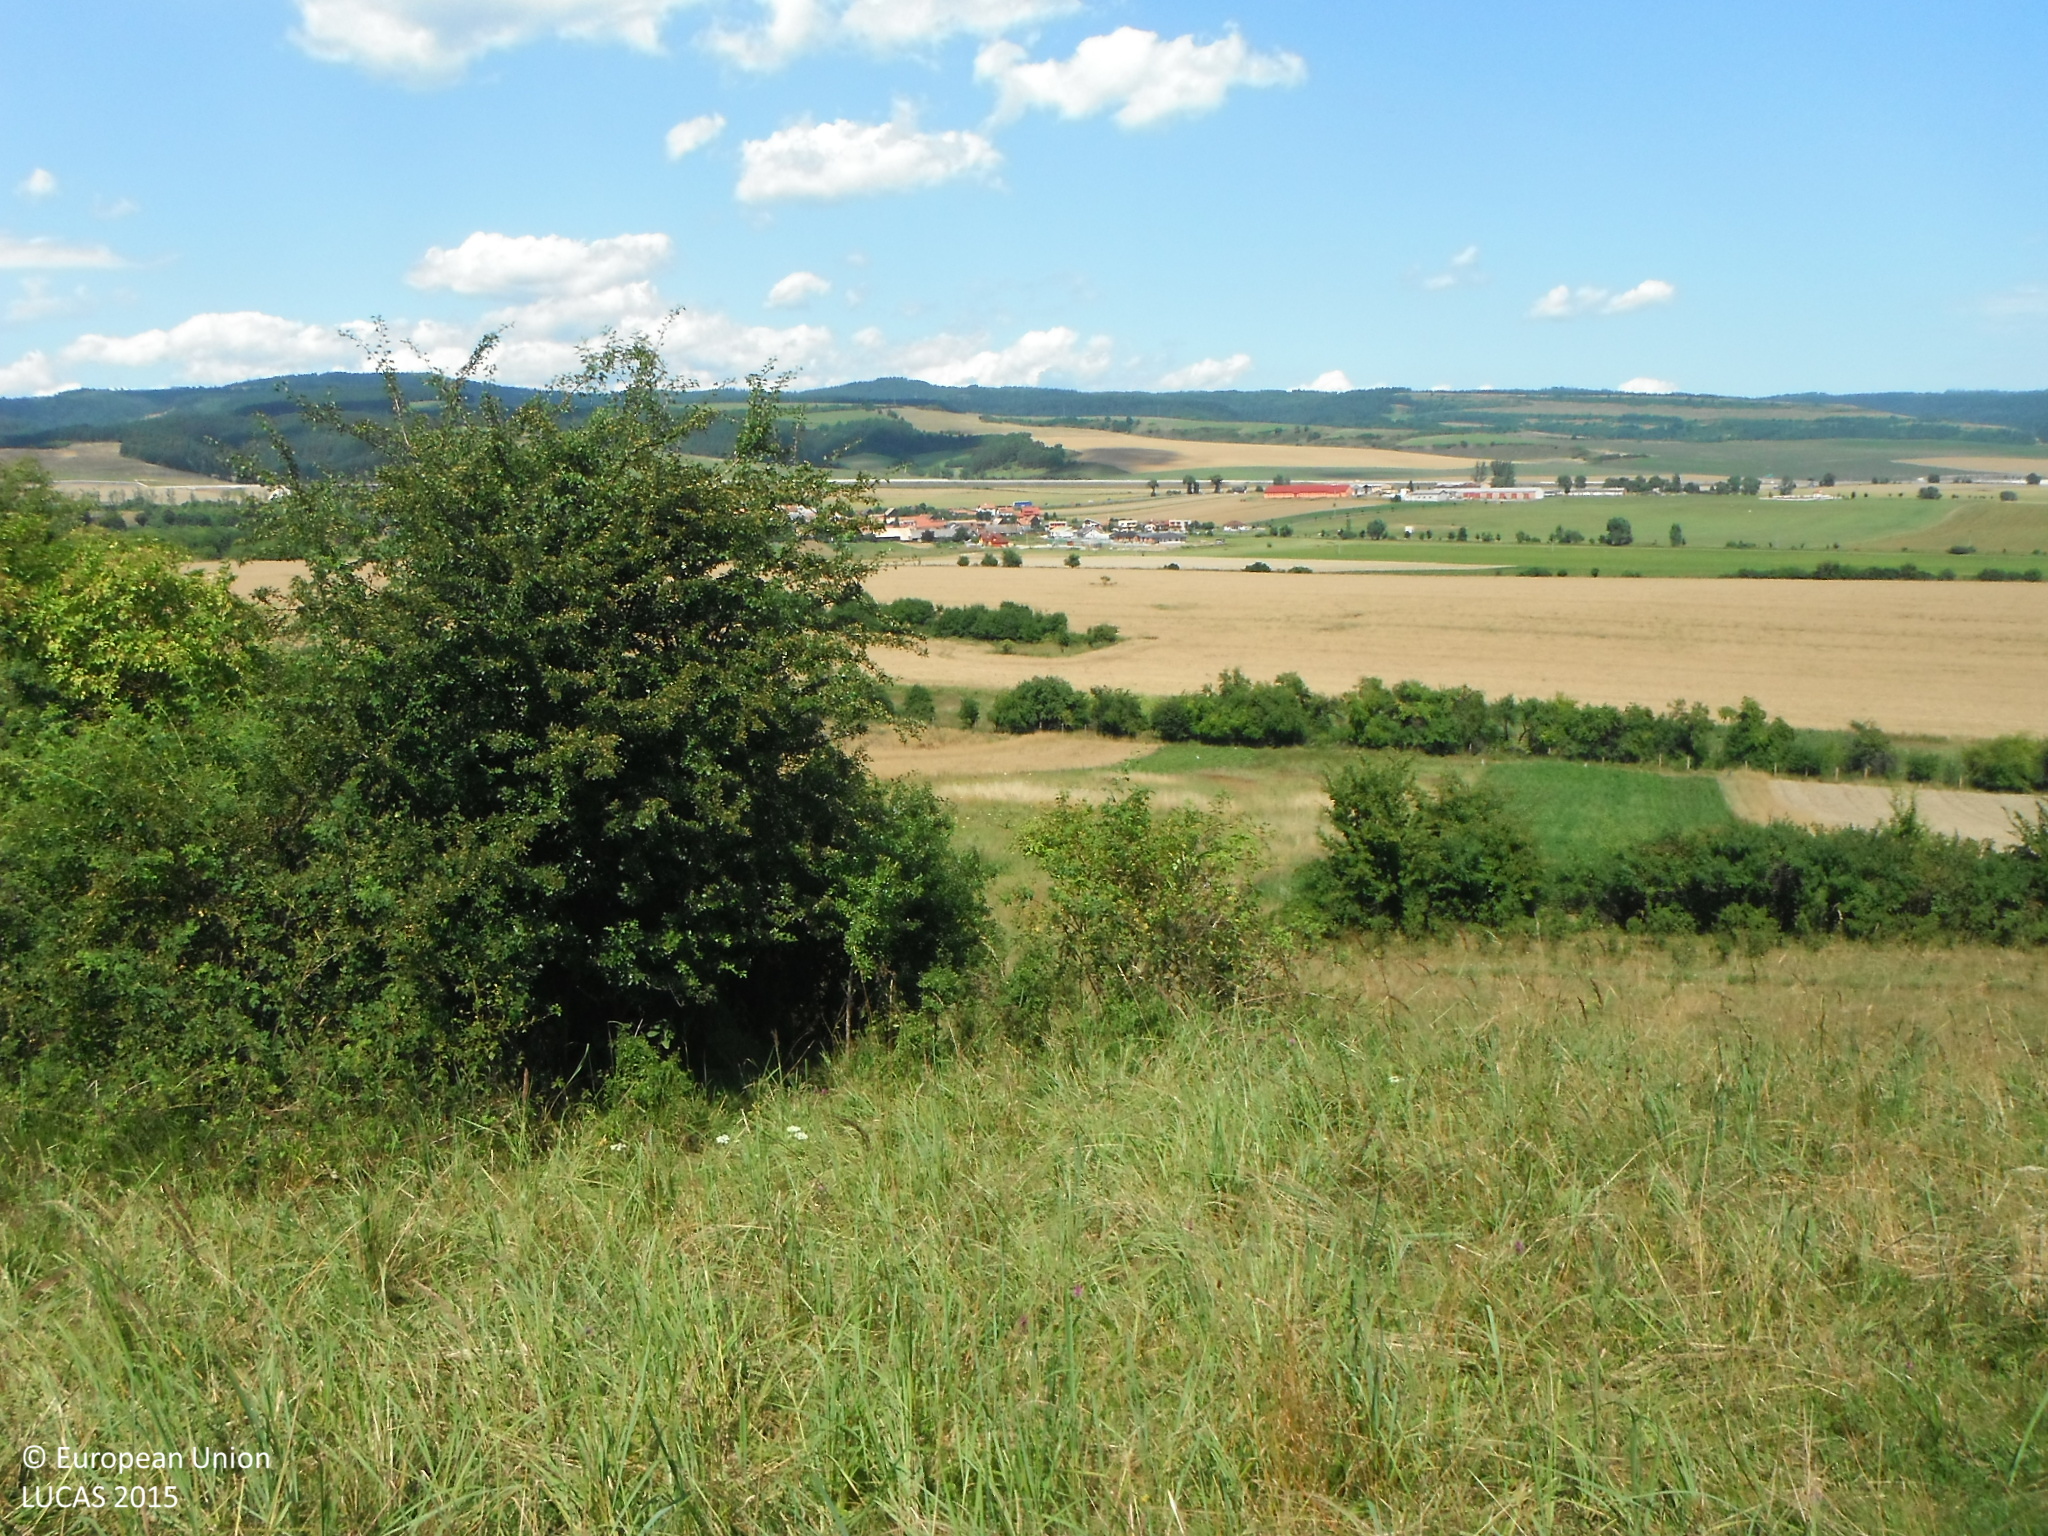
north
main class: Grassland
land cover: Grassland without tree/shrub cover
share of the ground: > 75 %
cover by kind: herbaceous plants 100 %
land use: Agriculture (excluding fallow land and kitchen gardens)
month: July
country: SK
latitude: 48.9912
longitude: 20.6843
